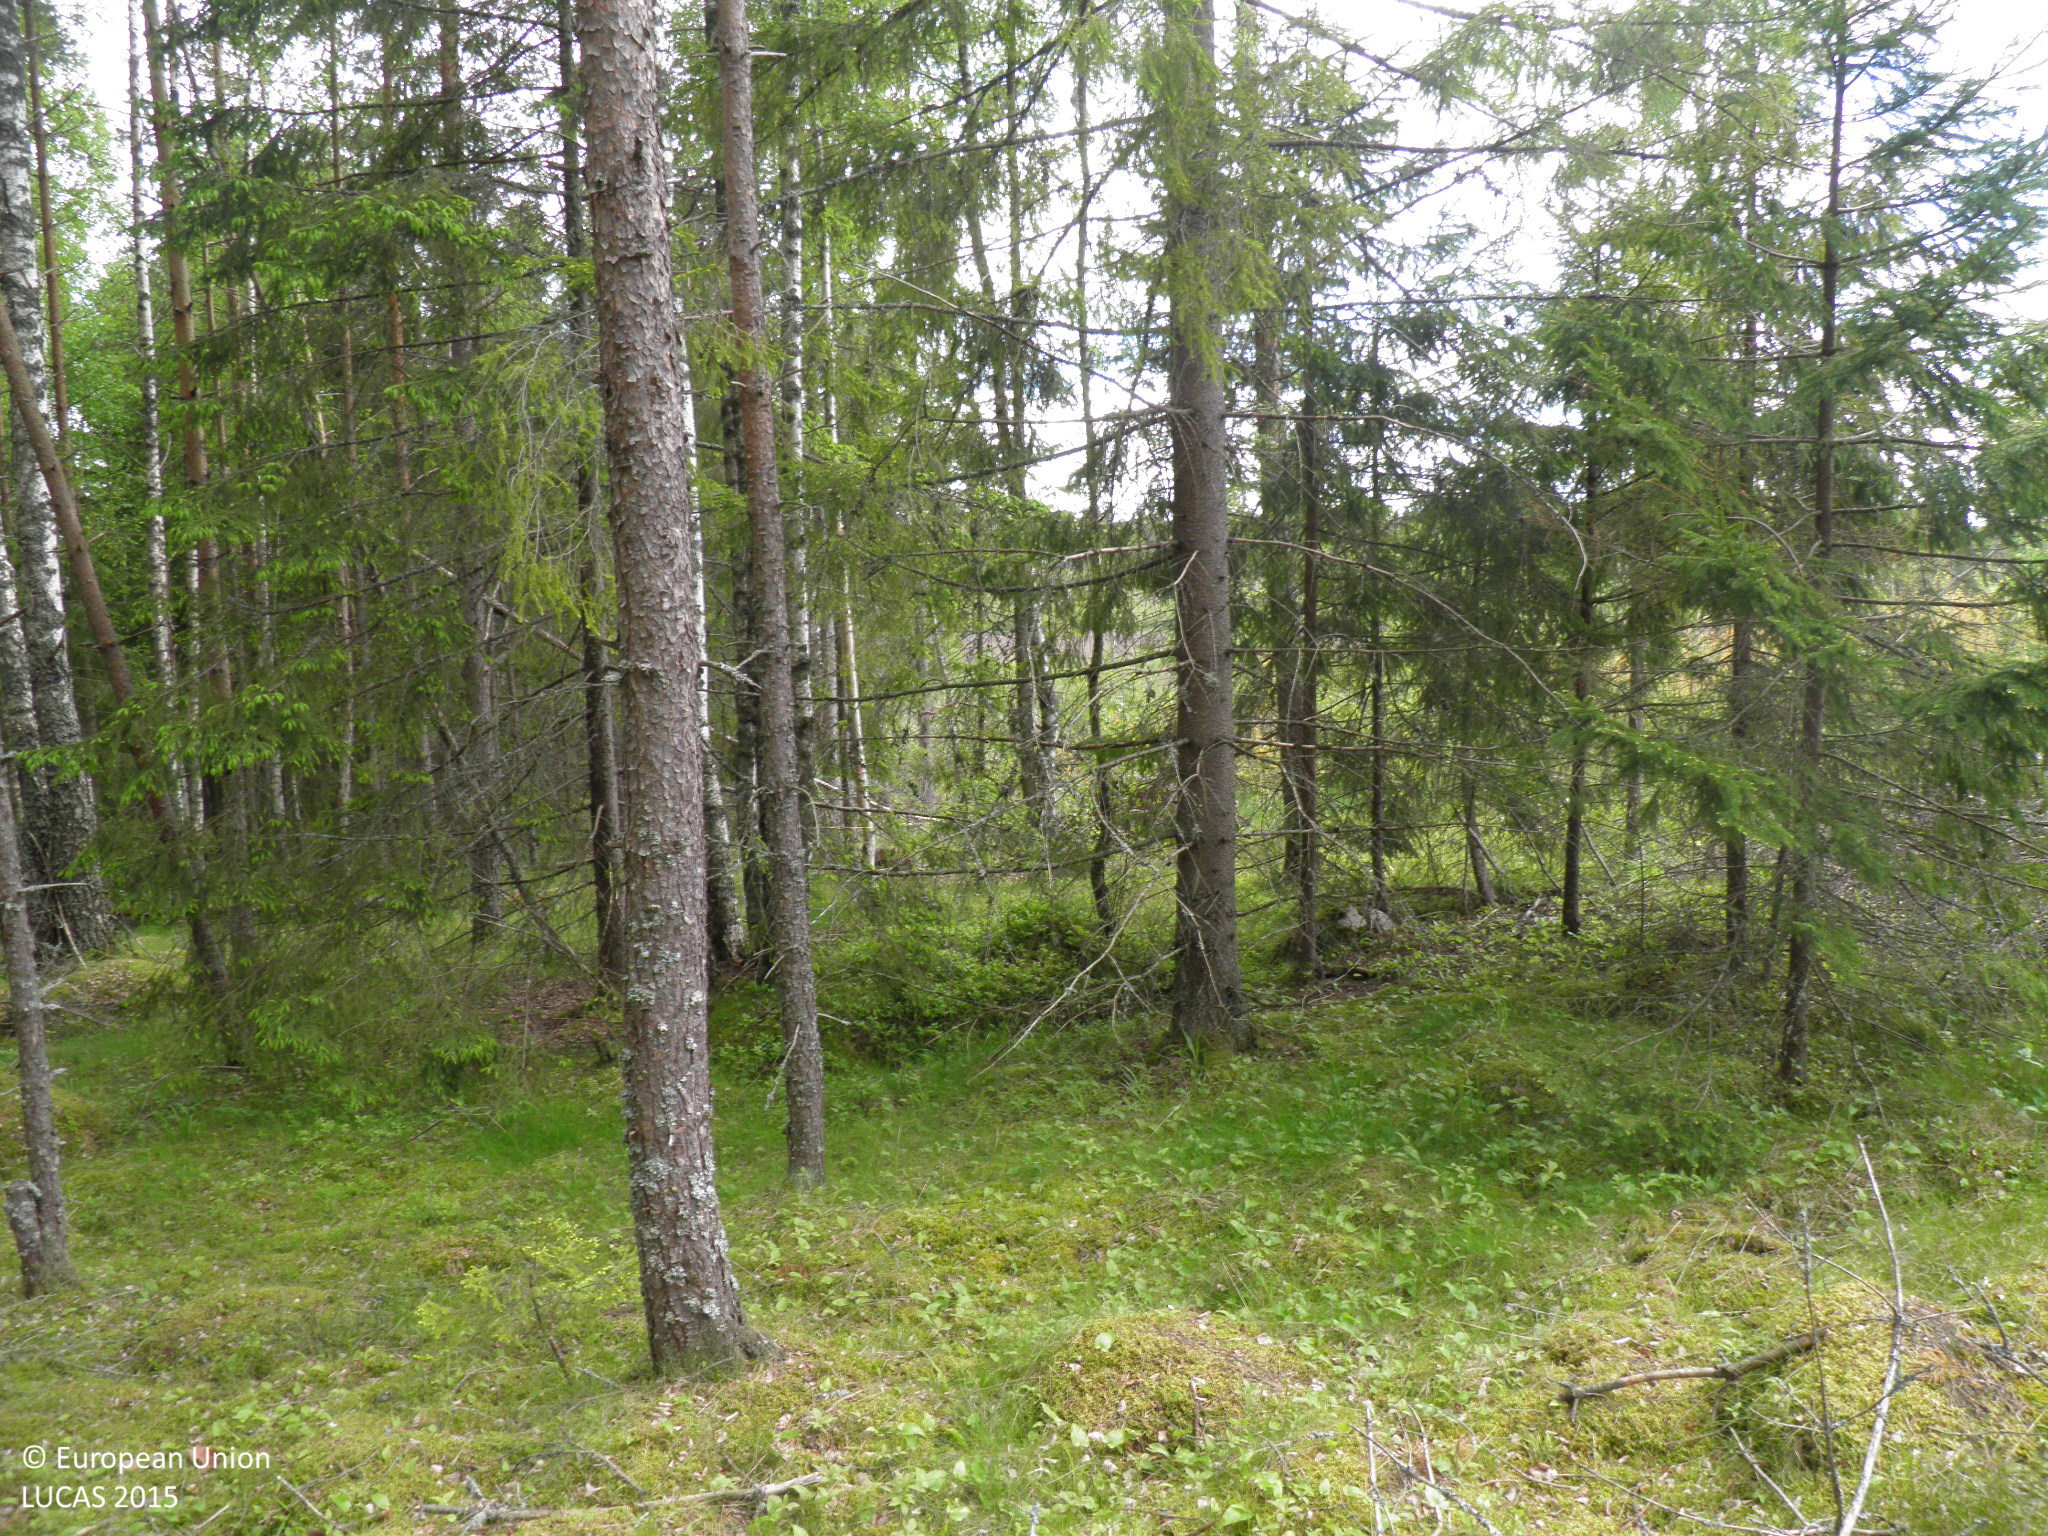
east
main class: Woodland
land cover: Pine dominated mixed woodland
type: hemiboreal forest and nemoral coniferous forest and mixed broadleaved-coniferous forest
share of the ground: > 75 %
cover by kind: coniferous forest trees 60 %, broadleaved forest trees 20 %, herbaceous plants 15 %, shrubs 5 %
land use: Forestry
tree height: > 5 m
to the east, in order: Pine dominated mixed woodland; Spruce dominated mixed woodland; Ditches and canals; Spruce dominated mixed woodland; Shrubland with sparse tree cover; Ditches and canals; Grass margins; Common wheat
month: June
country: FI
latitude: 60.5978
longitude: 22.6164
